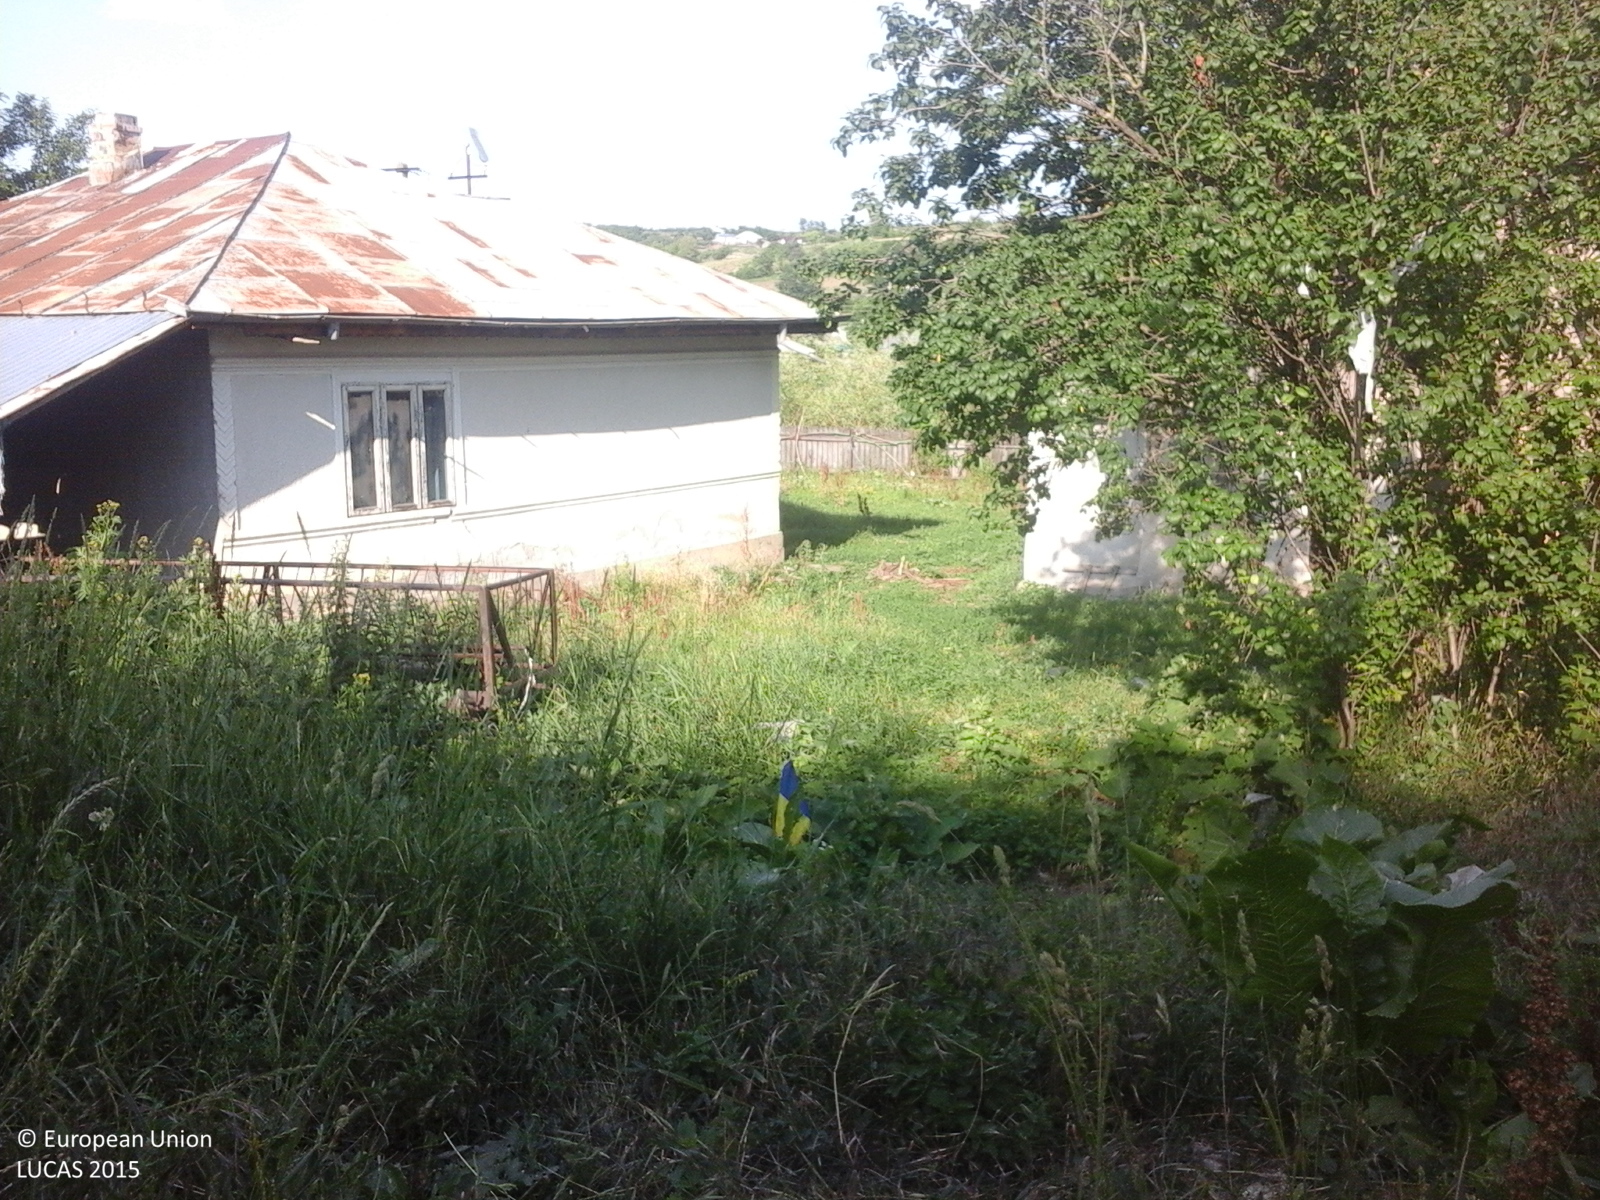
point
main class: Grassland
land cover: Grassland without tree/shrub cover
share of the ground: > 75 %
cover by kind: herbaceous plants 100 %
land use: Agriculture (excluding fallow land and kitchen gardens)
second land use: Residential
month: June
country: RO
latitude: 47.1618
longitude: 27.0255
